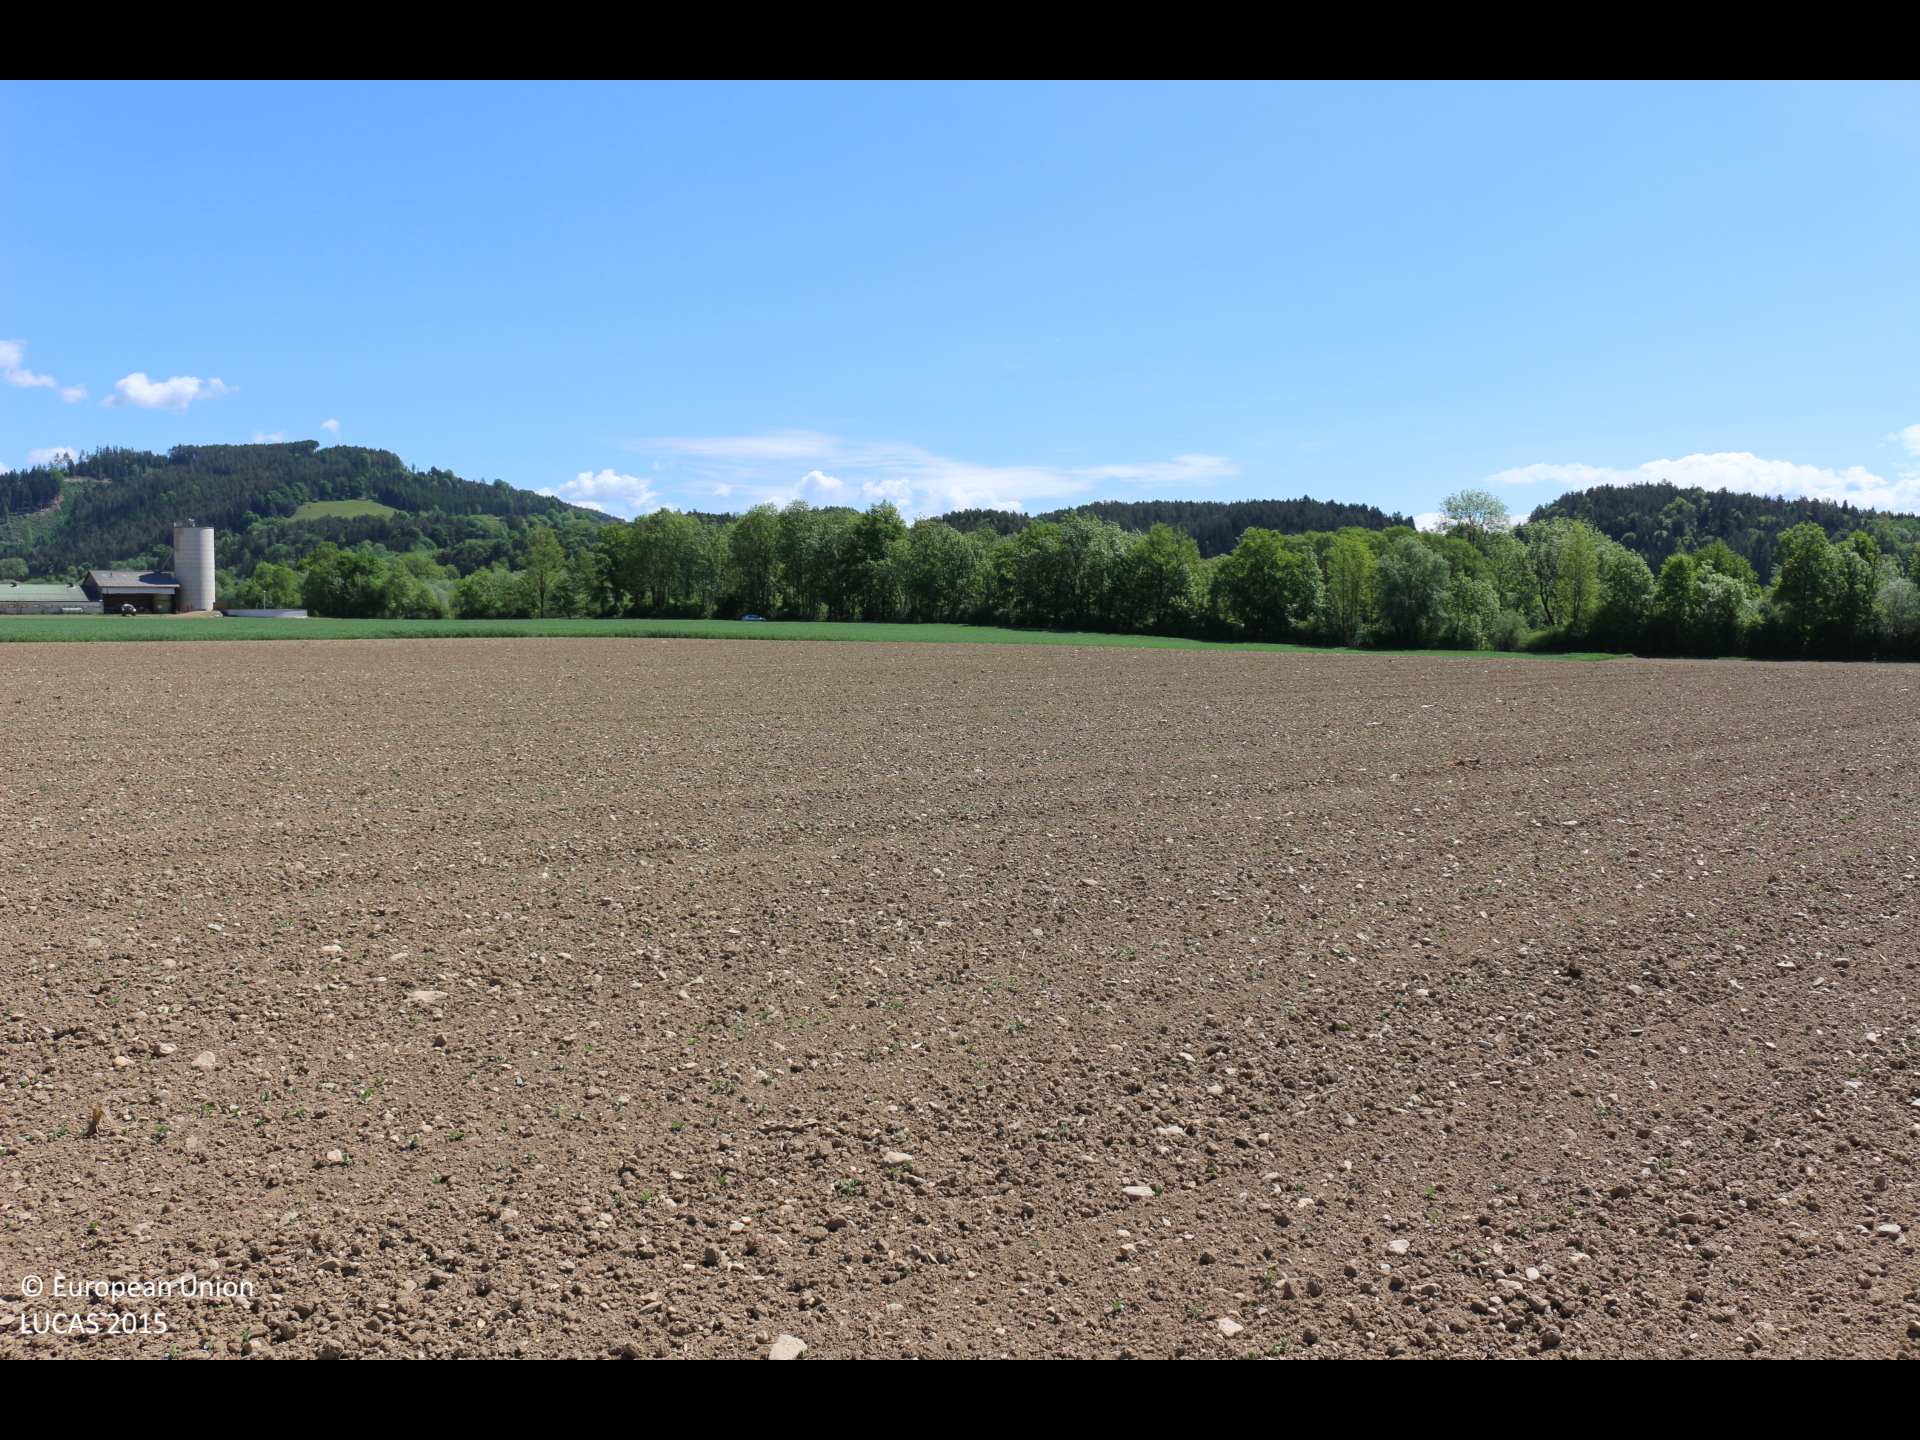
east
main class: Cropland
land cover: Soya
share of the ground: < 10 %
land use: Agriculture (excluding fallow land and kitchen gardens)
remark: Tilled/Sowed
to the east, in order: Soya; Common wheat
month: May
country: AT
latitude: 46.6743
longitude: 14.4291
